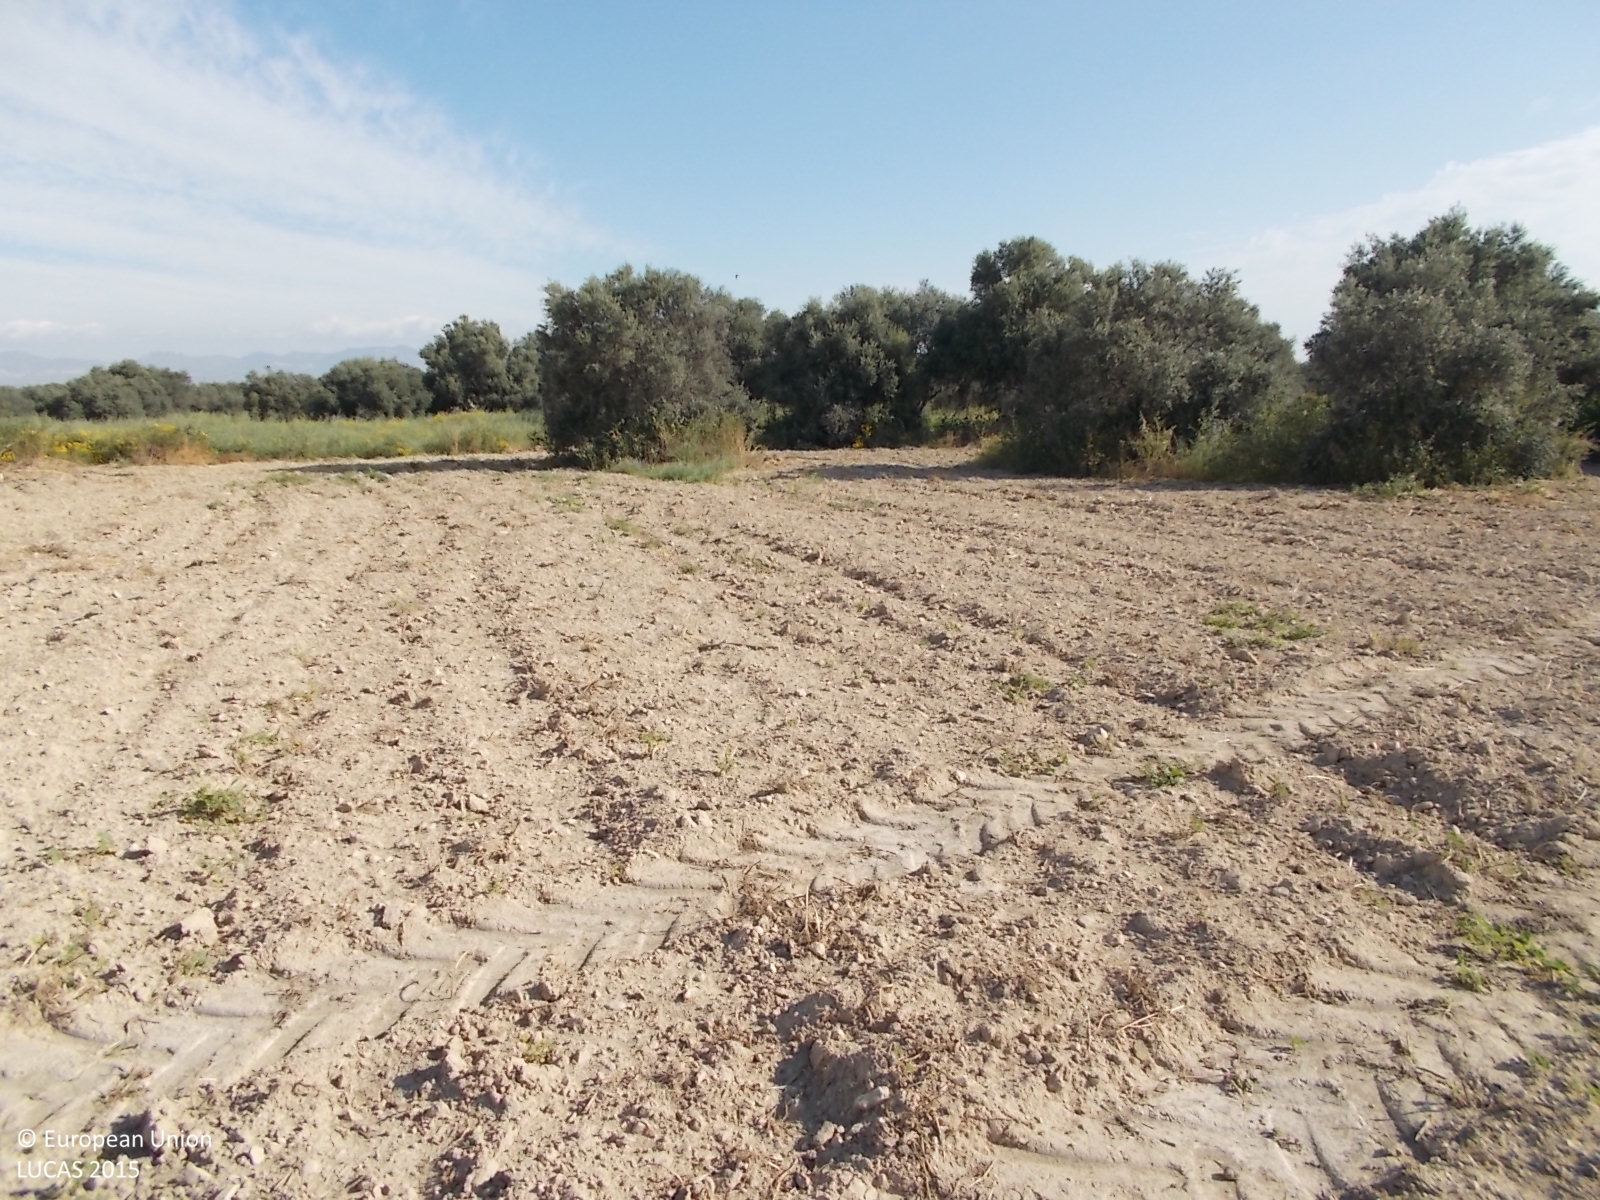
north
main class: Cropland
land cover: Other fresh vegetables
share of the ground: 10 - 25 %
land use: Agriculture (excluding fallow land and kitchen gardens)
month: April
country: CY
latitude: 35.0662
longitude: 33.5438
